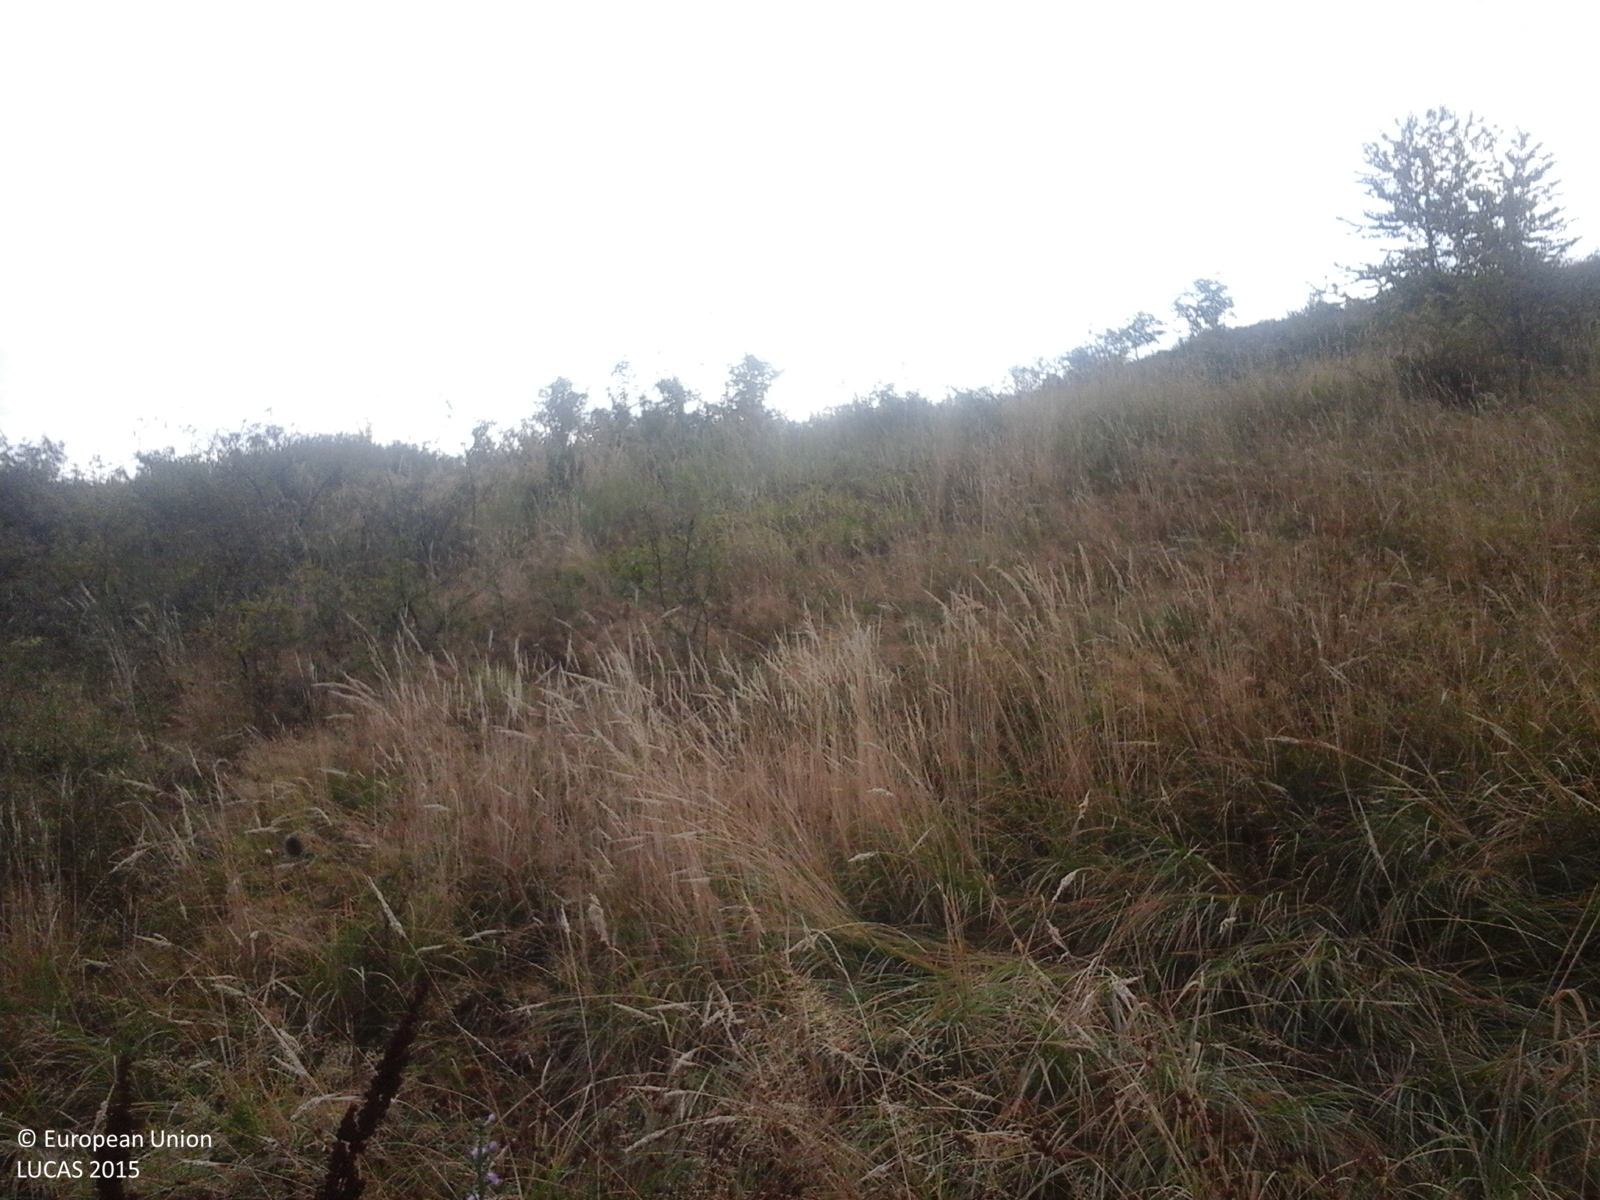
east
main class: Grassland
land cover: Grassland without tree/shrub cover
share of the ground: > 75 %
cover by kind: herbaceous plants 100 %
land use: Agriculture (excluding fallow land and kitchen gardens)
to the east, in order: Grassland without tree/shrub cover; Shrubland with sparse tree cover; Grassland without tree/shrub cover; Shrubland with sparse tree cover; Tracks; Shrubland with sparse tree cover; Abandoned hedges; Shrubland with sparse tree cover
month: August
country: RO
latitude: 44.7738
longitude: 22.8202
